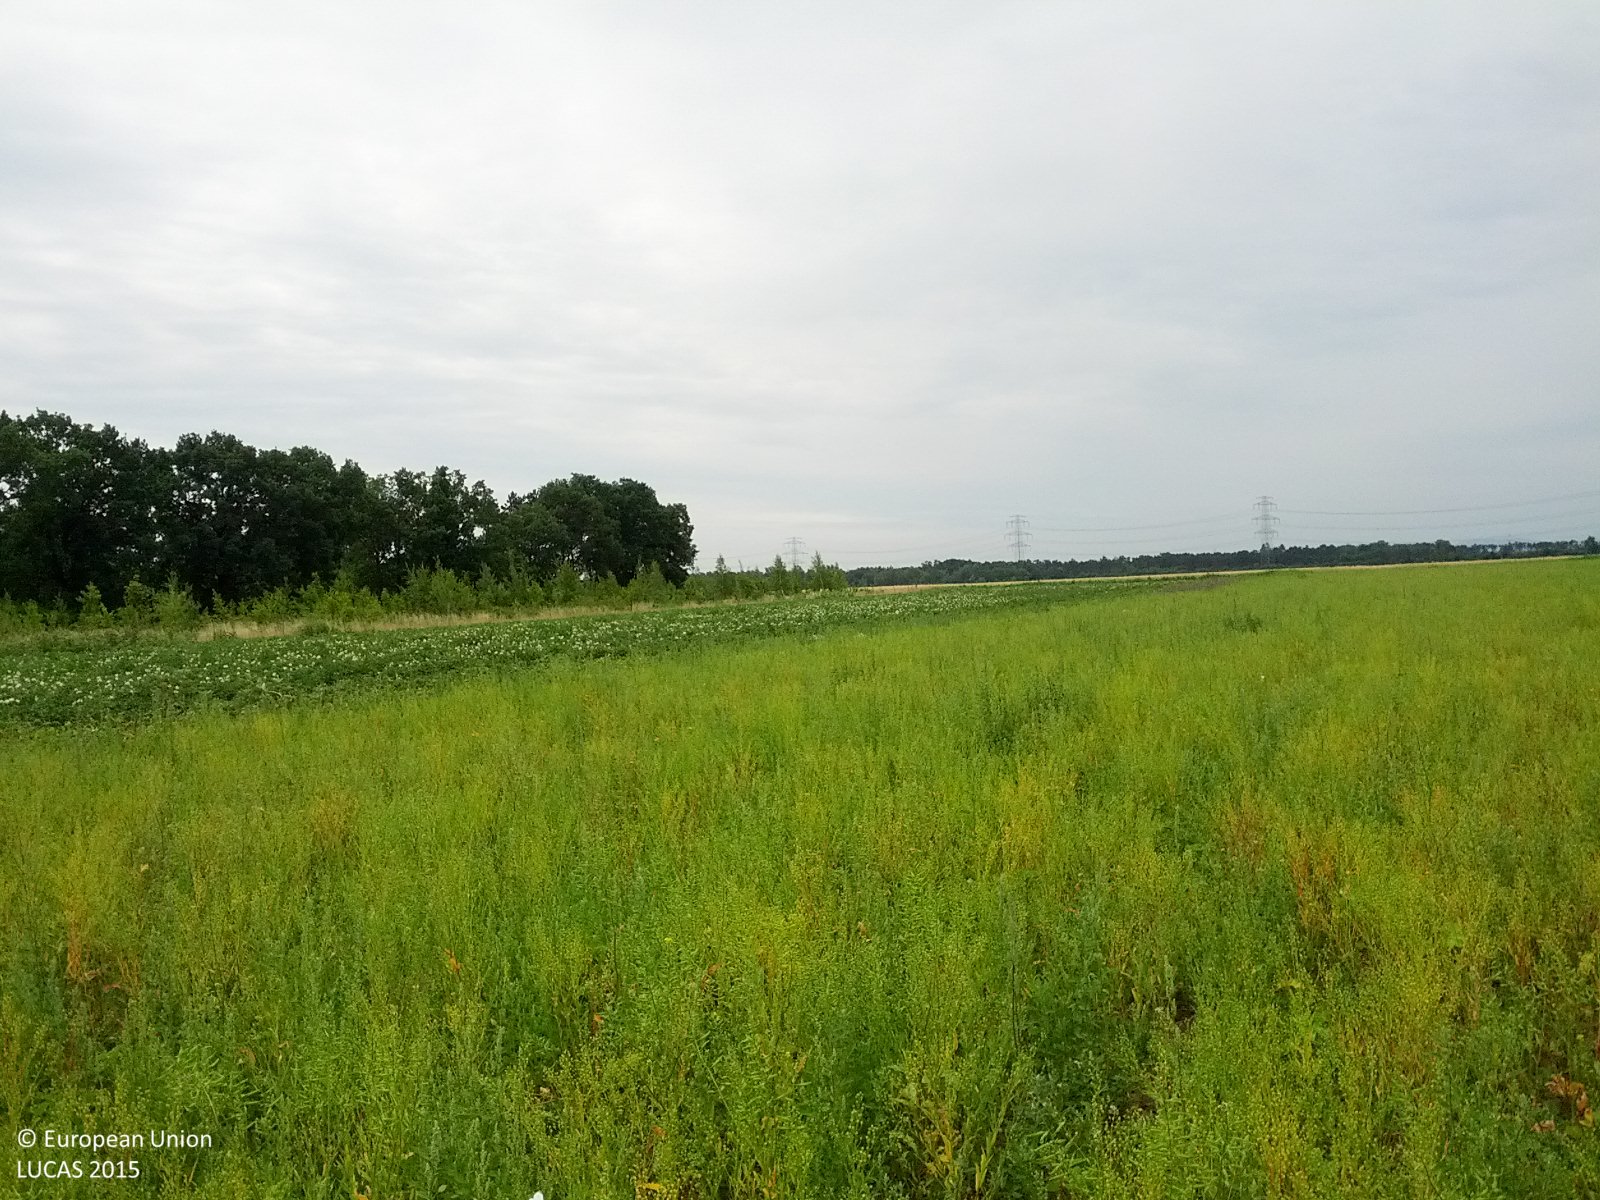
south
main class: Cropland
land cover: Clovers
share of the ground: 25 - 50 %
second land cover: Other fibre and oleaginous crops
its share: 25 - 50 %
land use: Agriculture (excluding fallow land and kitchen gardens)
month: June
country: AT
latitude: 48.3178
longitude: 16.5463
